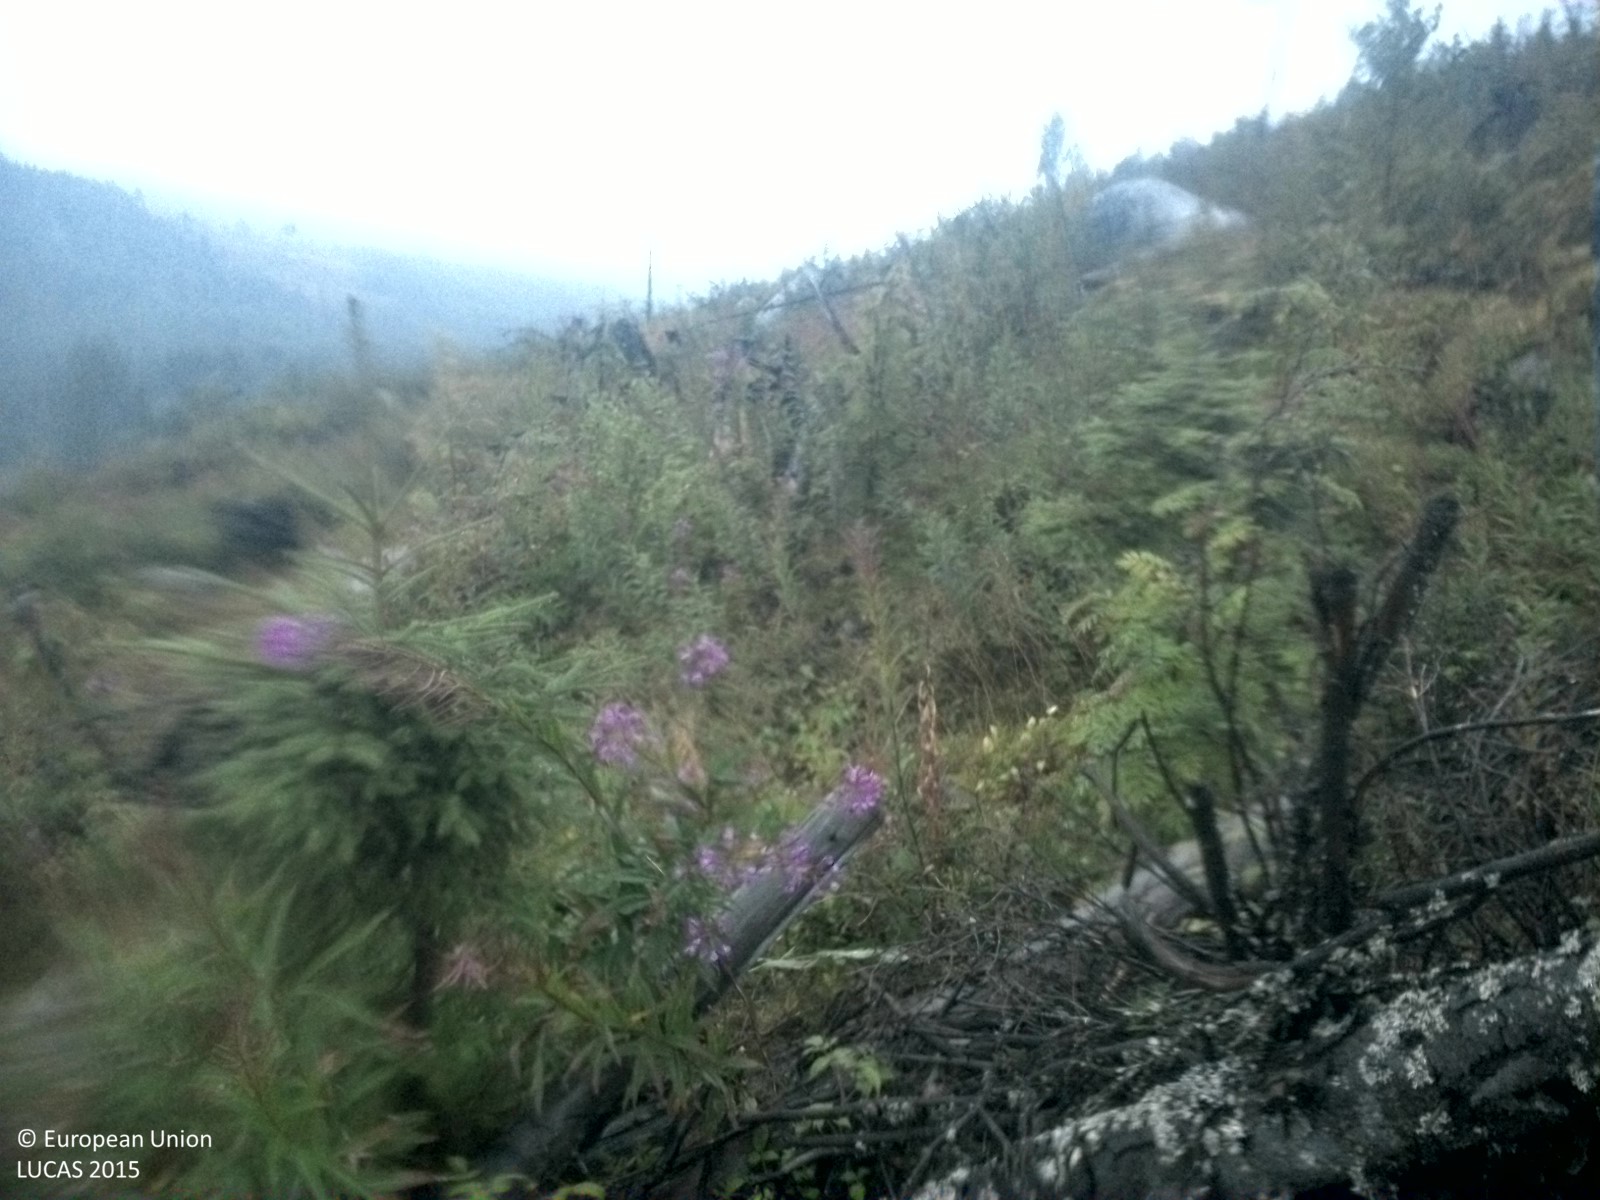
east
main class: Woodland
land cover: Spruce dominated mixed woodland
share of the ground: 10 - 25 %
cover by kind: herbaceous plants 35 %, shrubs 30 %, coniferous forest trees 15 %, consolidated bare surface 10 %, broadleaved forest trees 5 %, unconsolidated bare surface 5 %
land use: Forestry
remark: Clear cut
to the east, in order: Spruce dominated mixed woodland; Broadleaved woodland; Tracks; Broadleaved woodland; Tracks; Broadleaved woodland; Other mixed woodland
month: August
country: SE
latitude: 62.3719
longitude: 16.3007
